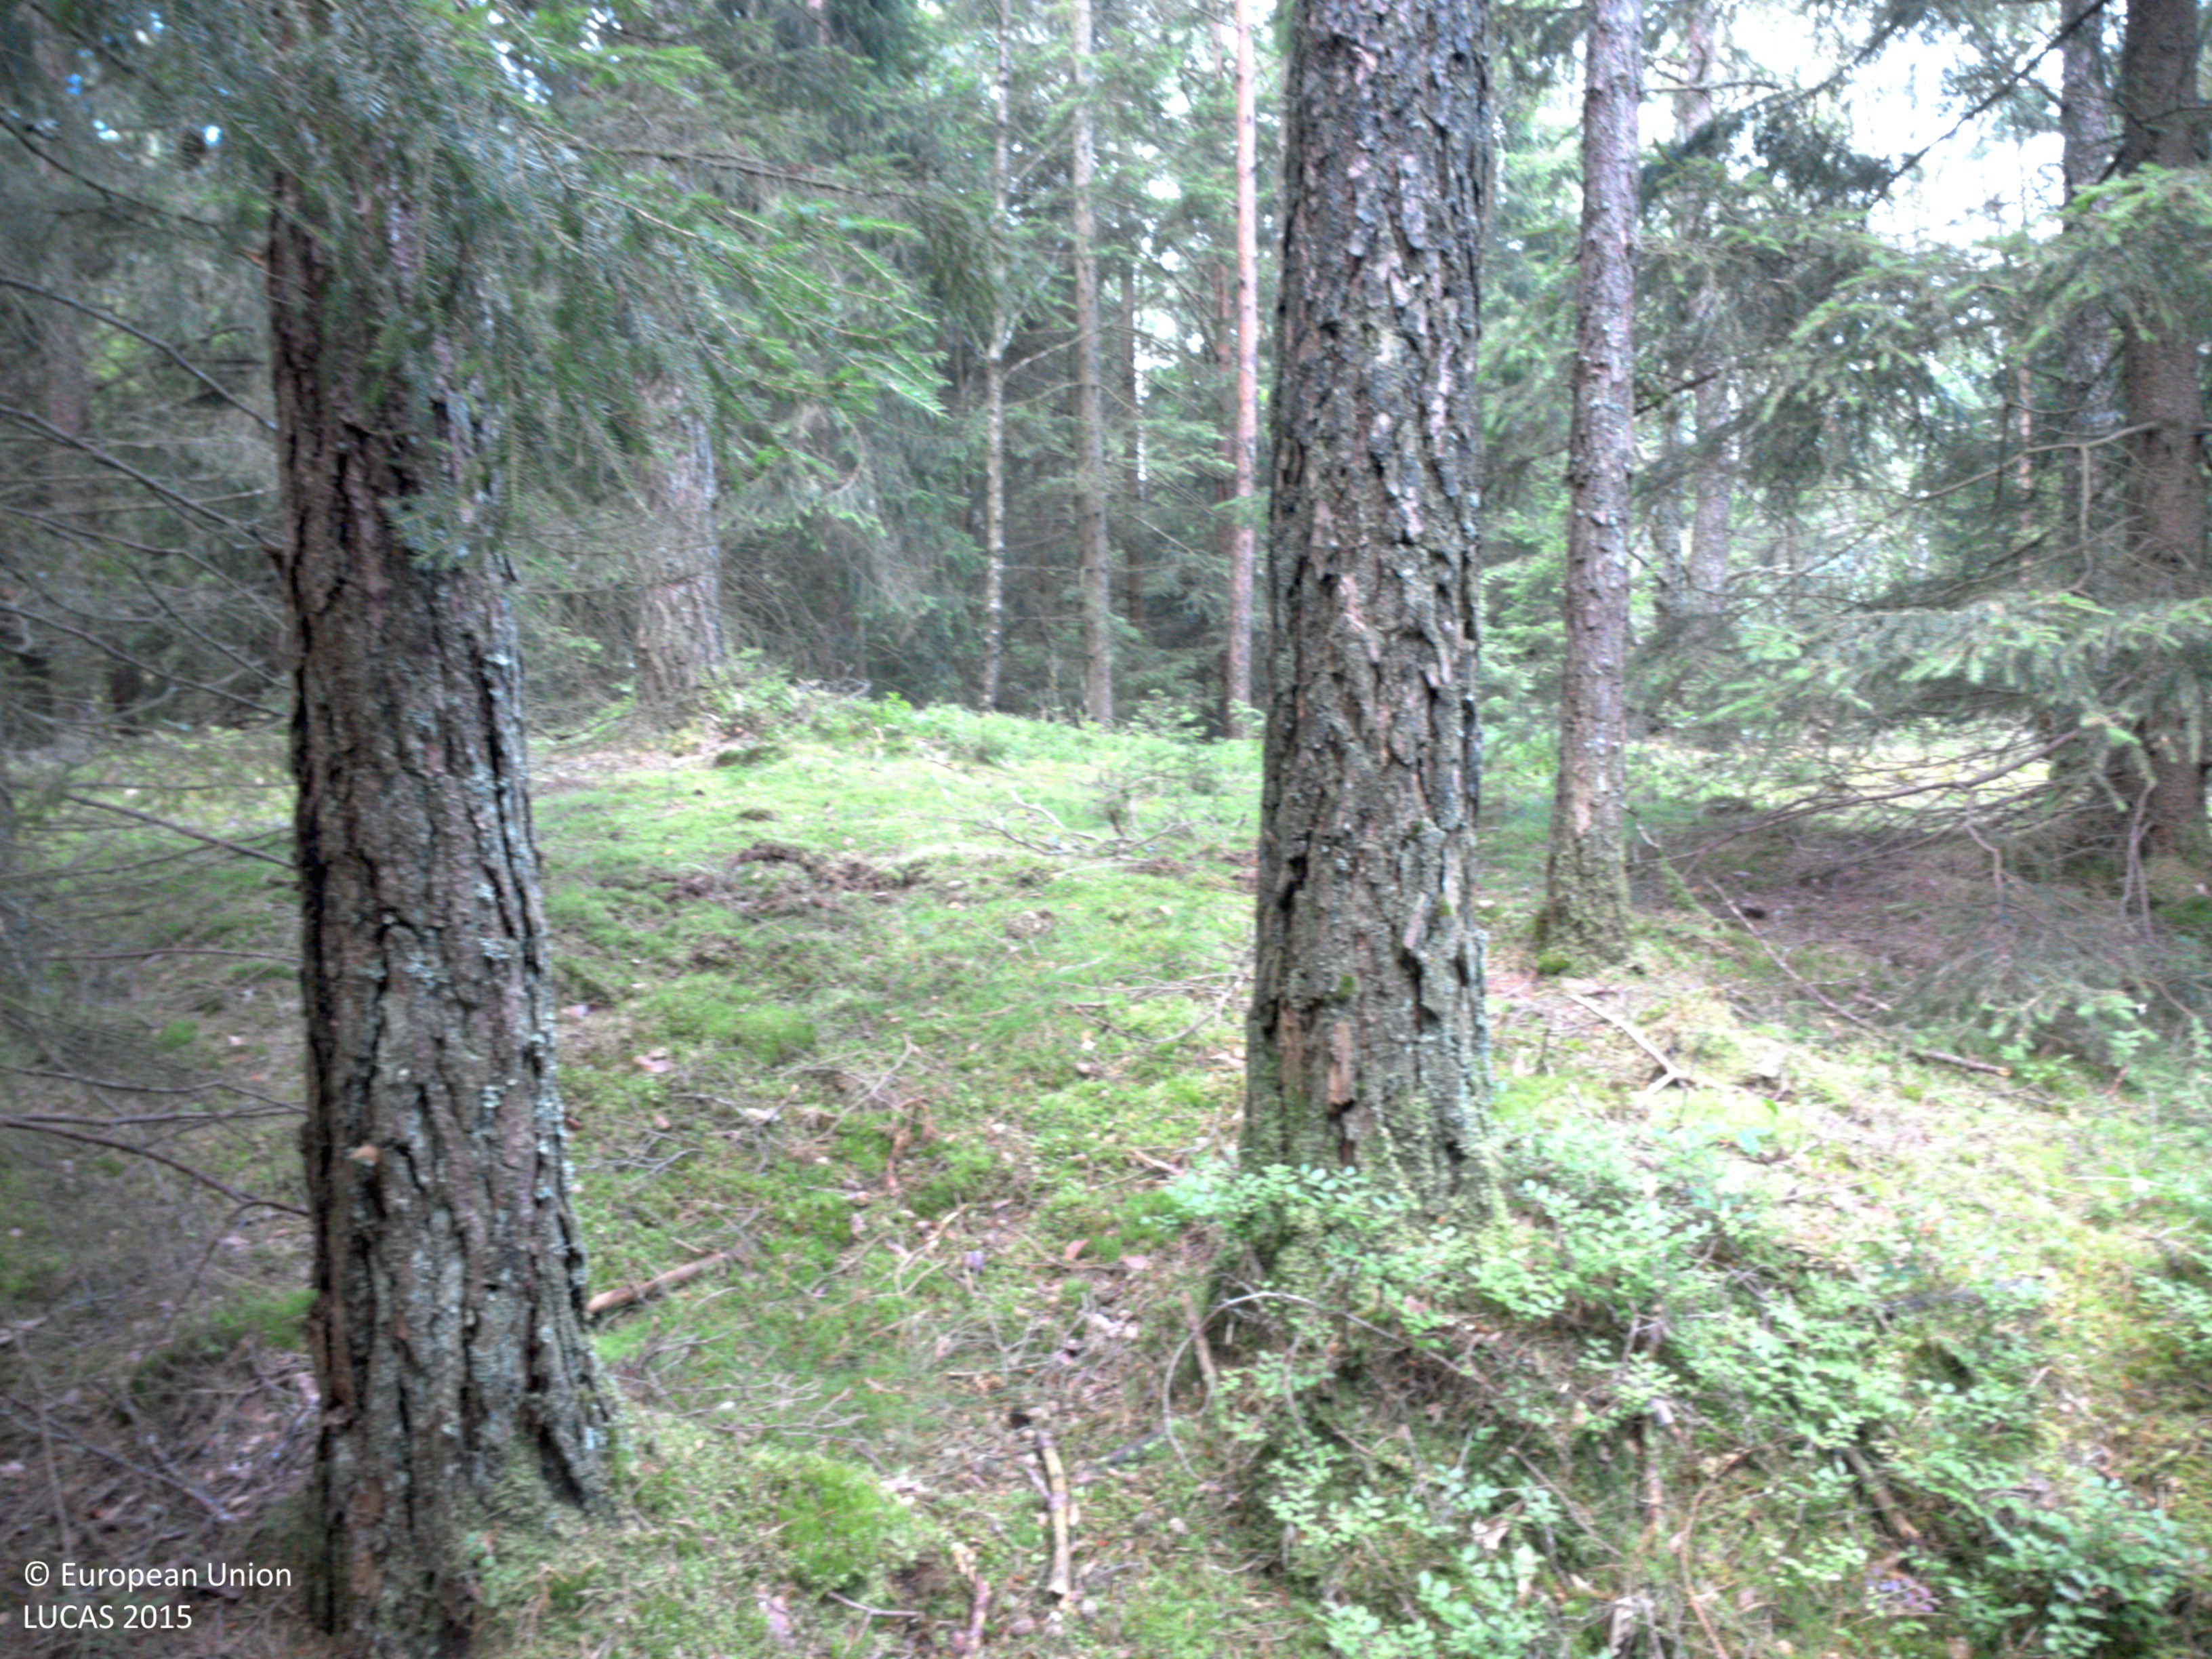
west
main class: Woodland
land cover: Other coniferous woodland
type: boreal forest
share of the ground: 50 - 75 %
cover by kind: coniferous forest trees 50 %, lichens and mosses 35 %, shrubs 15 %
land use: Forestry
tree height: > 5 m
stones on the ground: < 10 %
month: August
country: SE
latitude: 57.9352
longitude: 11.9725
